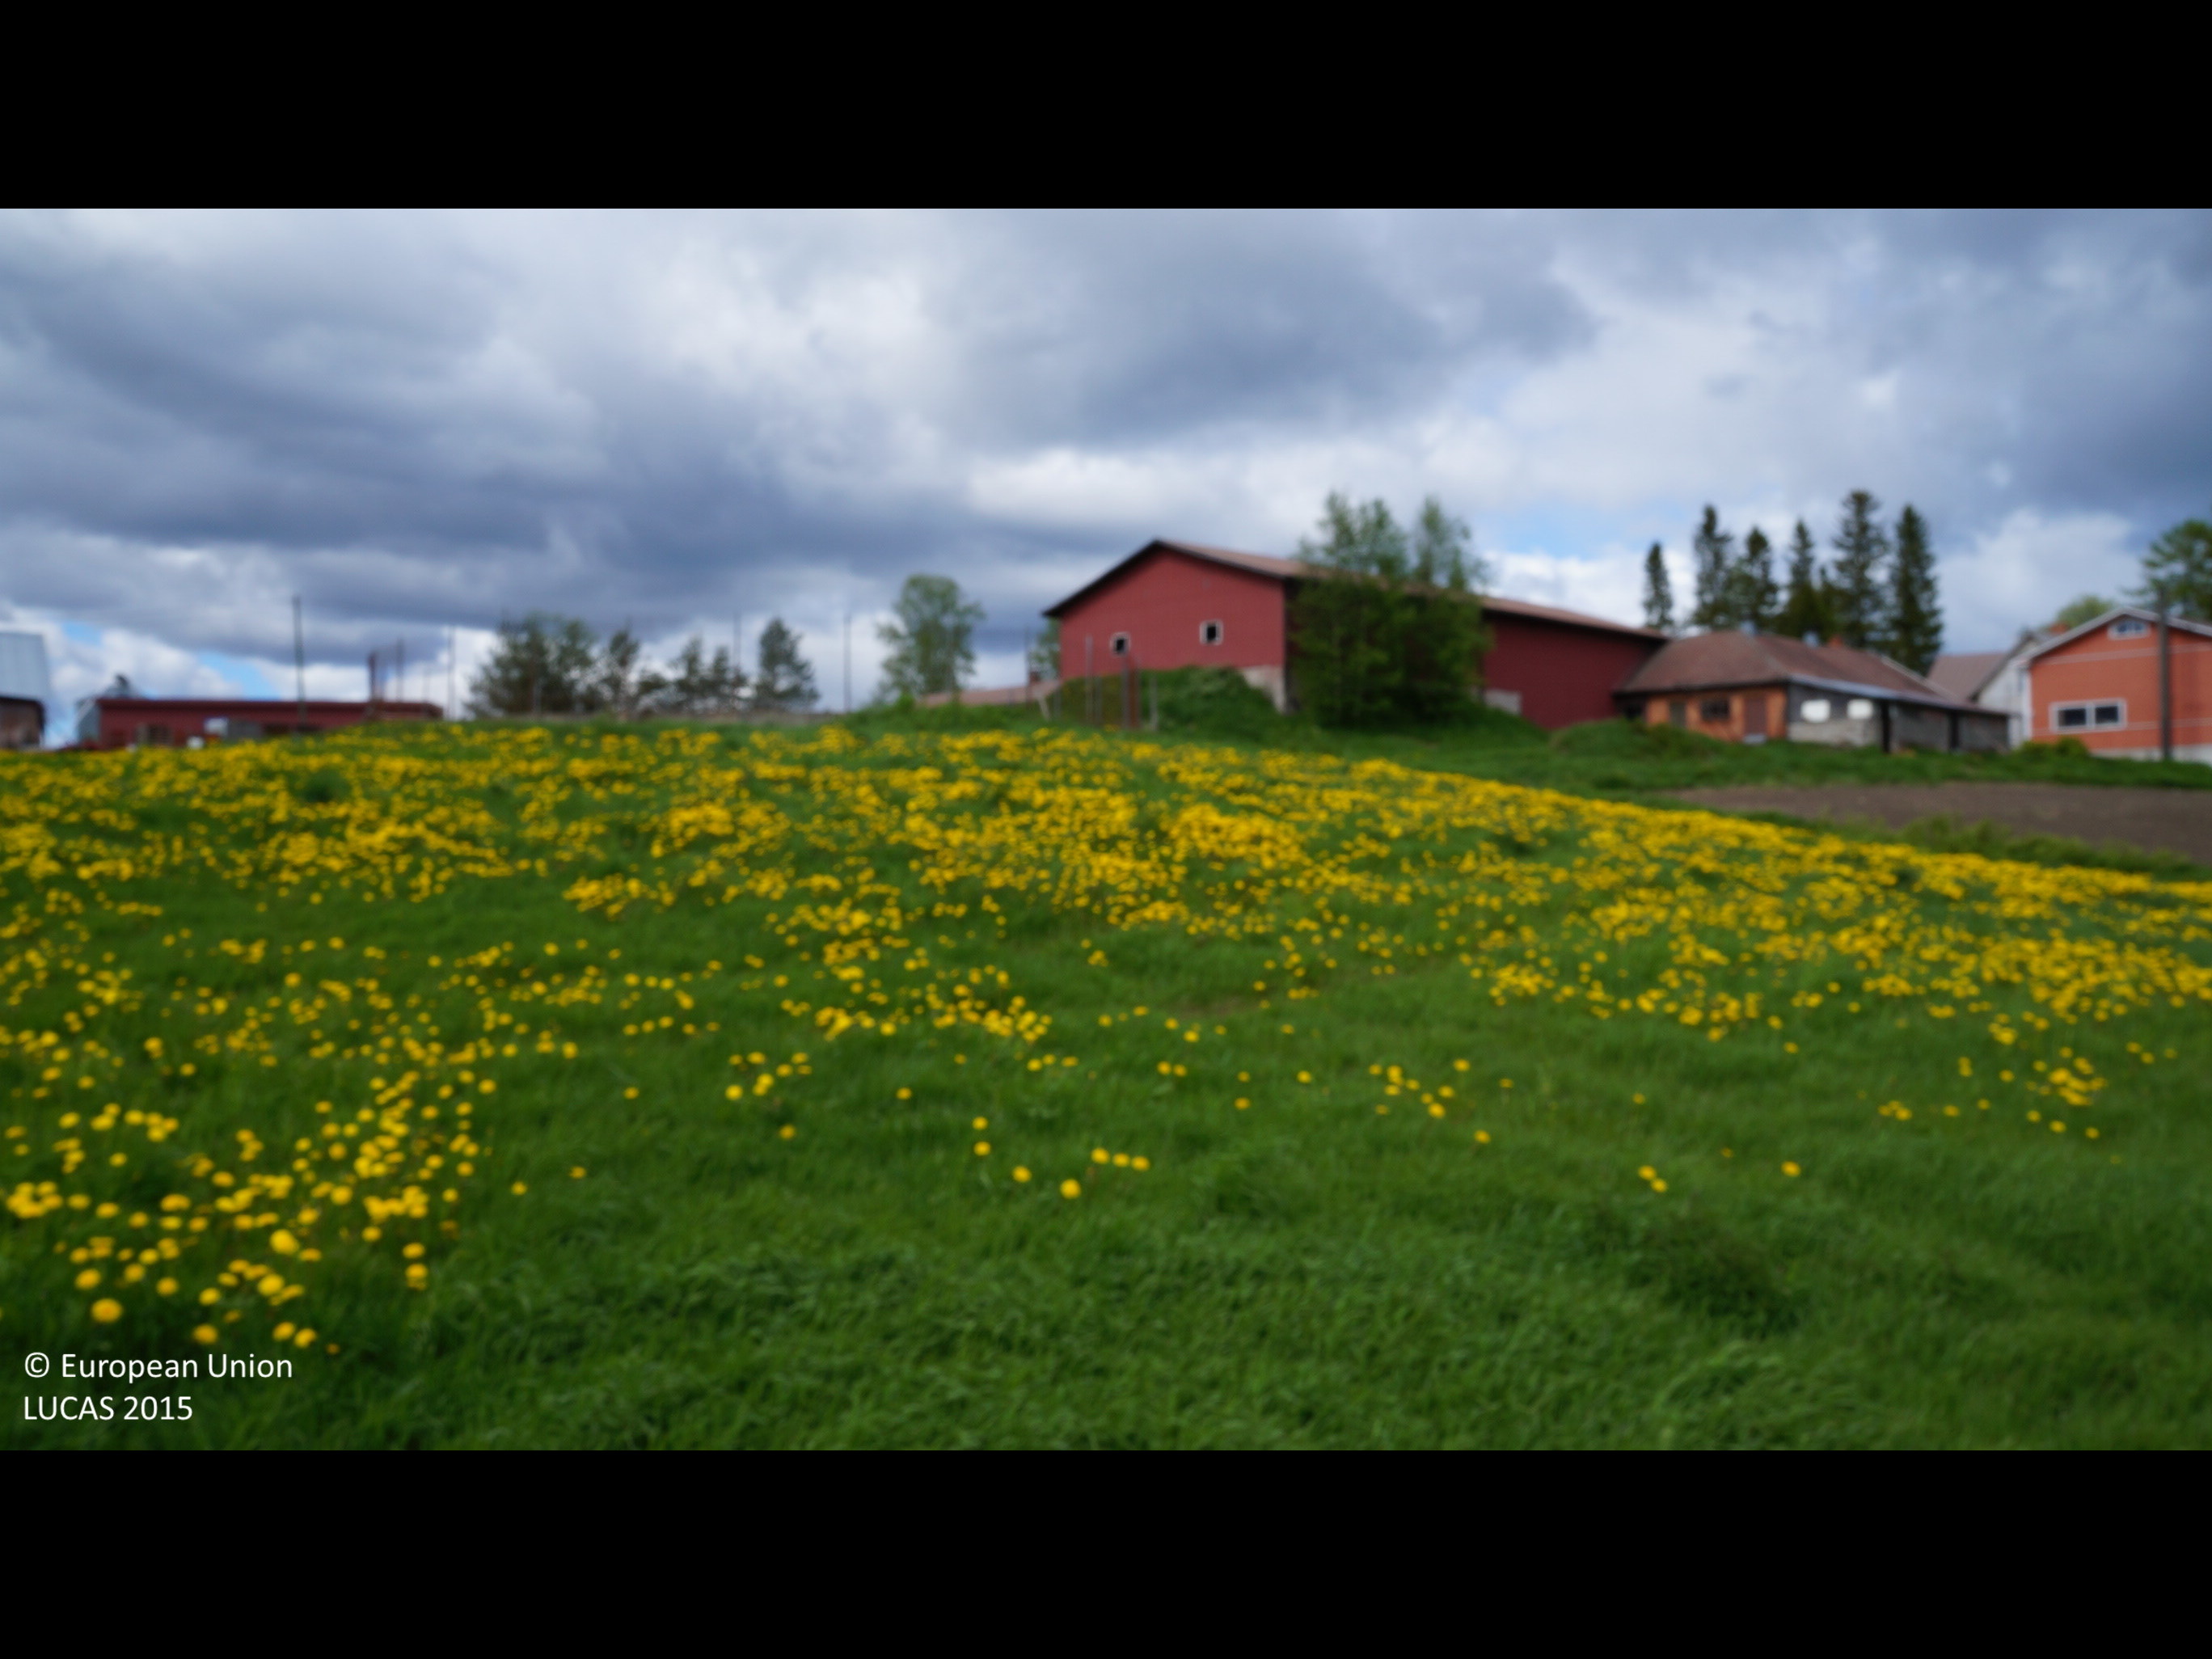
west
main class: Cropland
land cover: Temporary grasslands
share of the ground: > 75 %
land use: Agriculture (excluding fallow land and kitchen gardens)
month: June
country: FI
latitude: 63.7657
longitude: 24.2868
